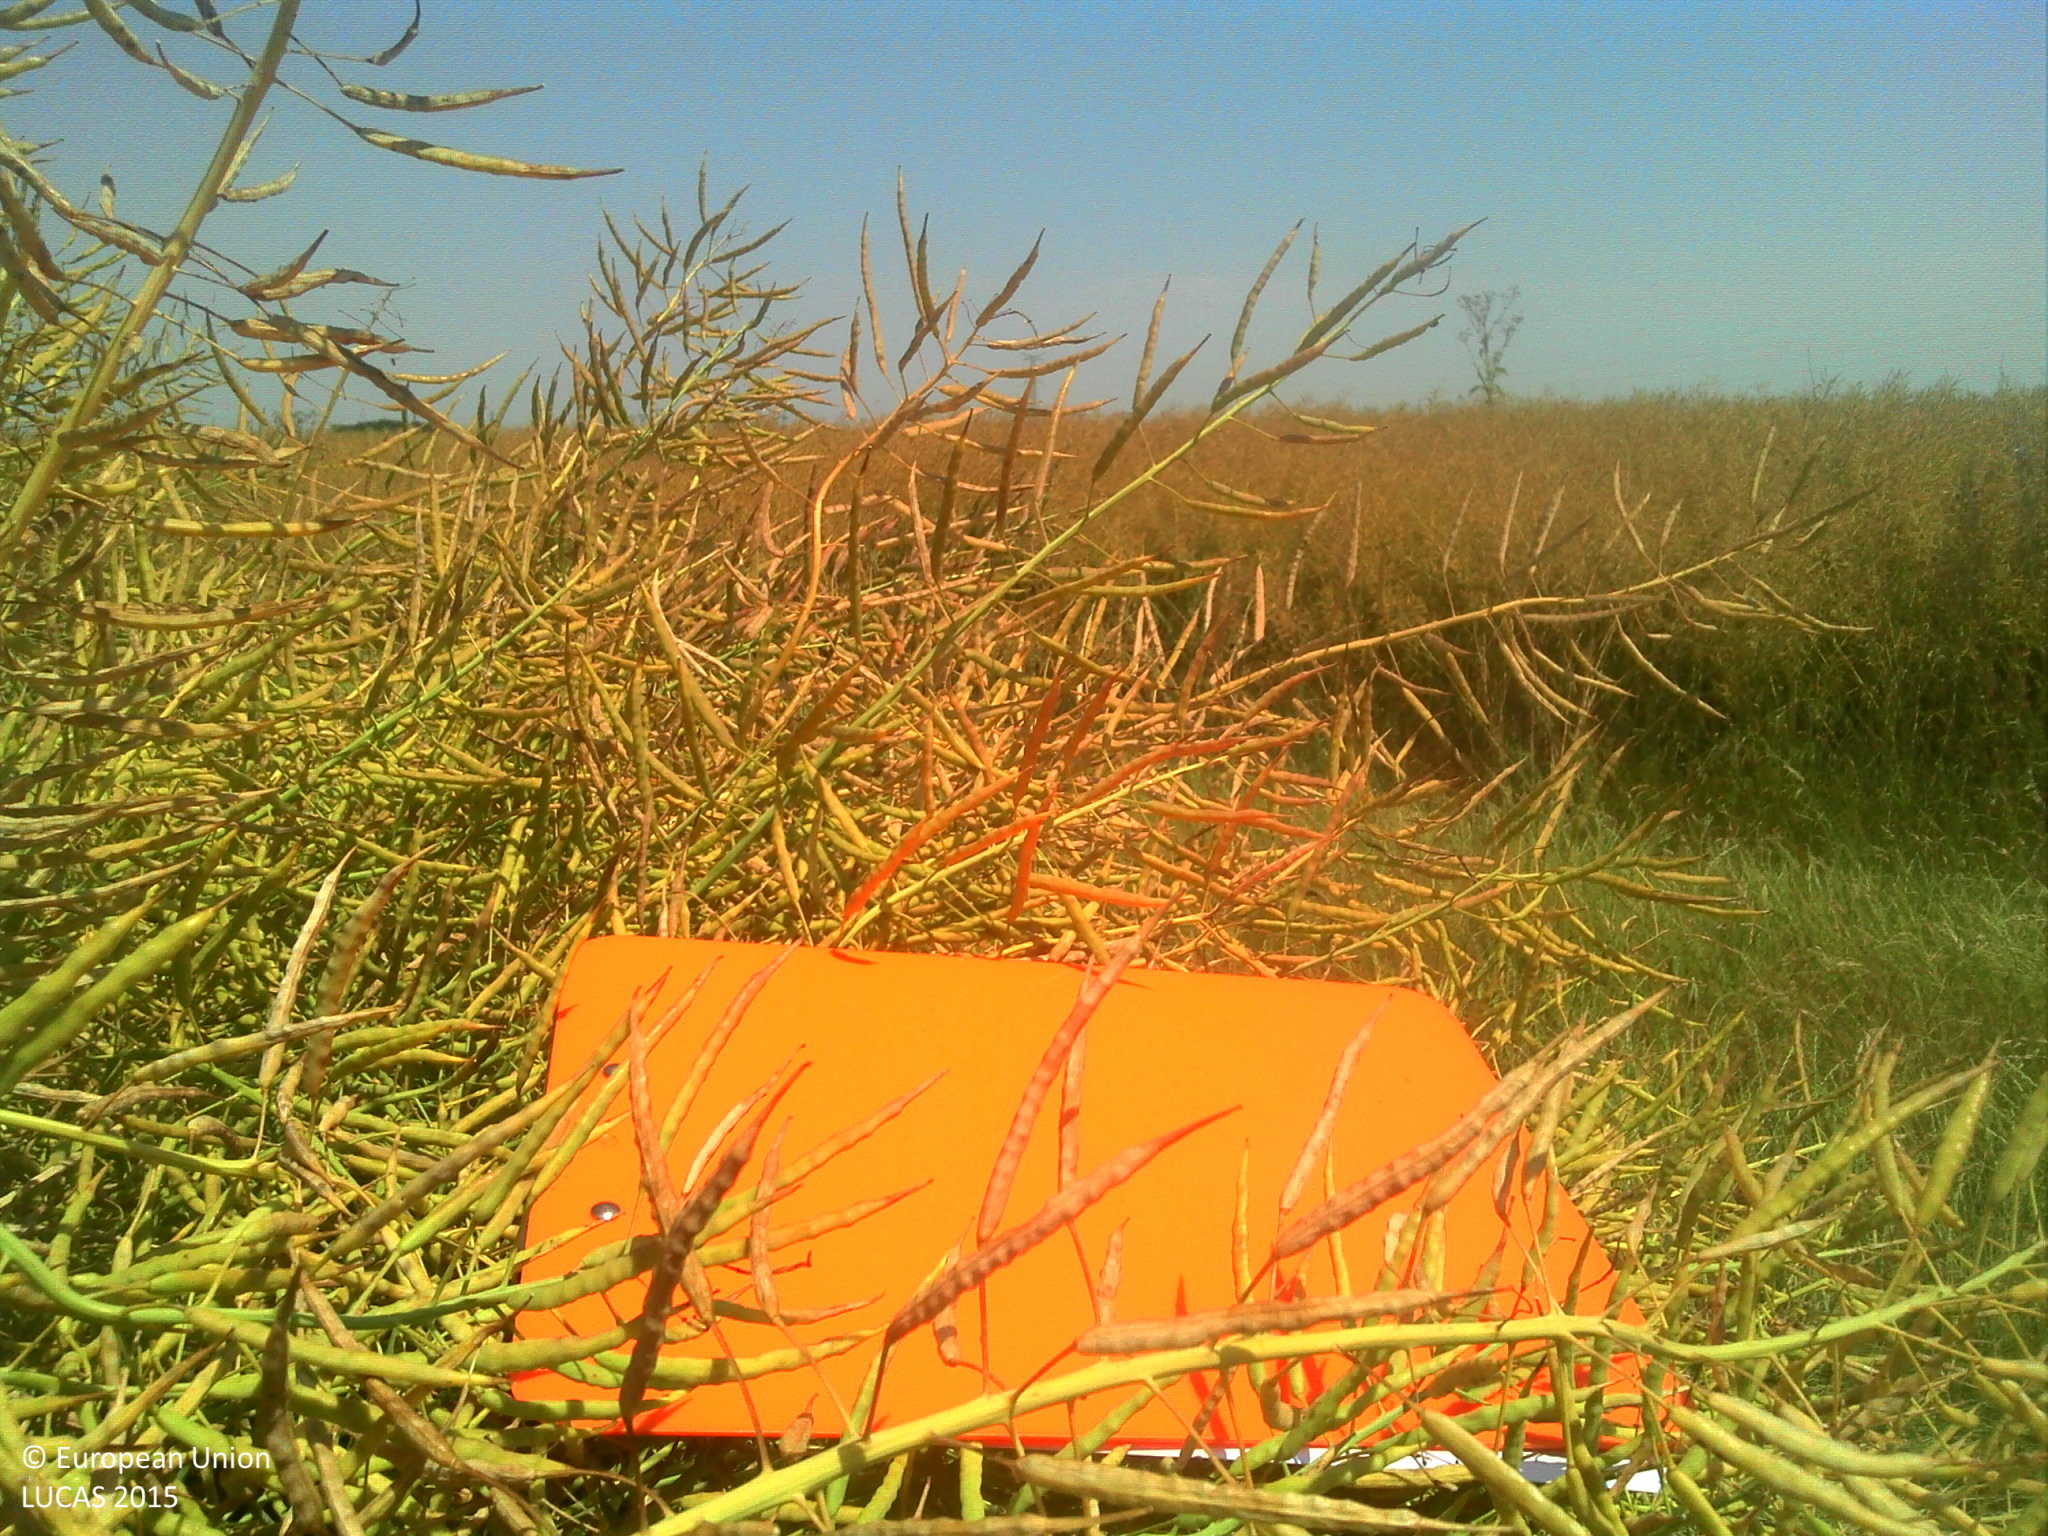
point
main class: Cropland
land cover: Rape and turnip rape
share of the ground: > 75 %
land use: Agriculture (excluding fallow land and kitchen gardens)
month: July
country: FR
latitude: 48.6997
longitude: 1.3812
